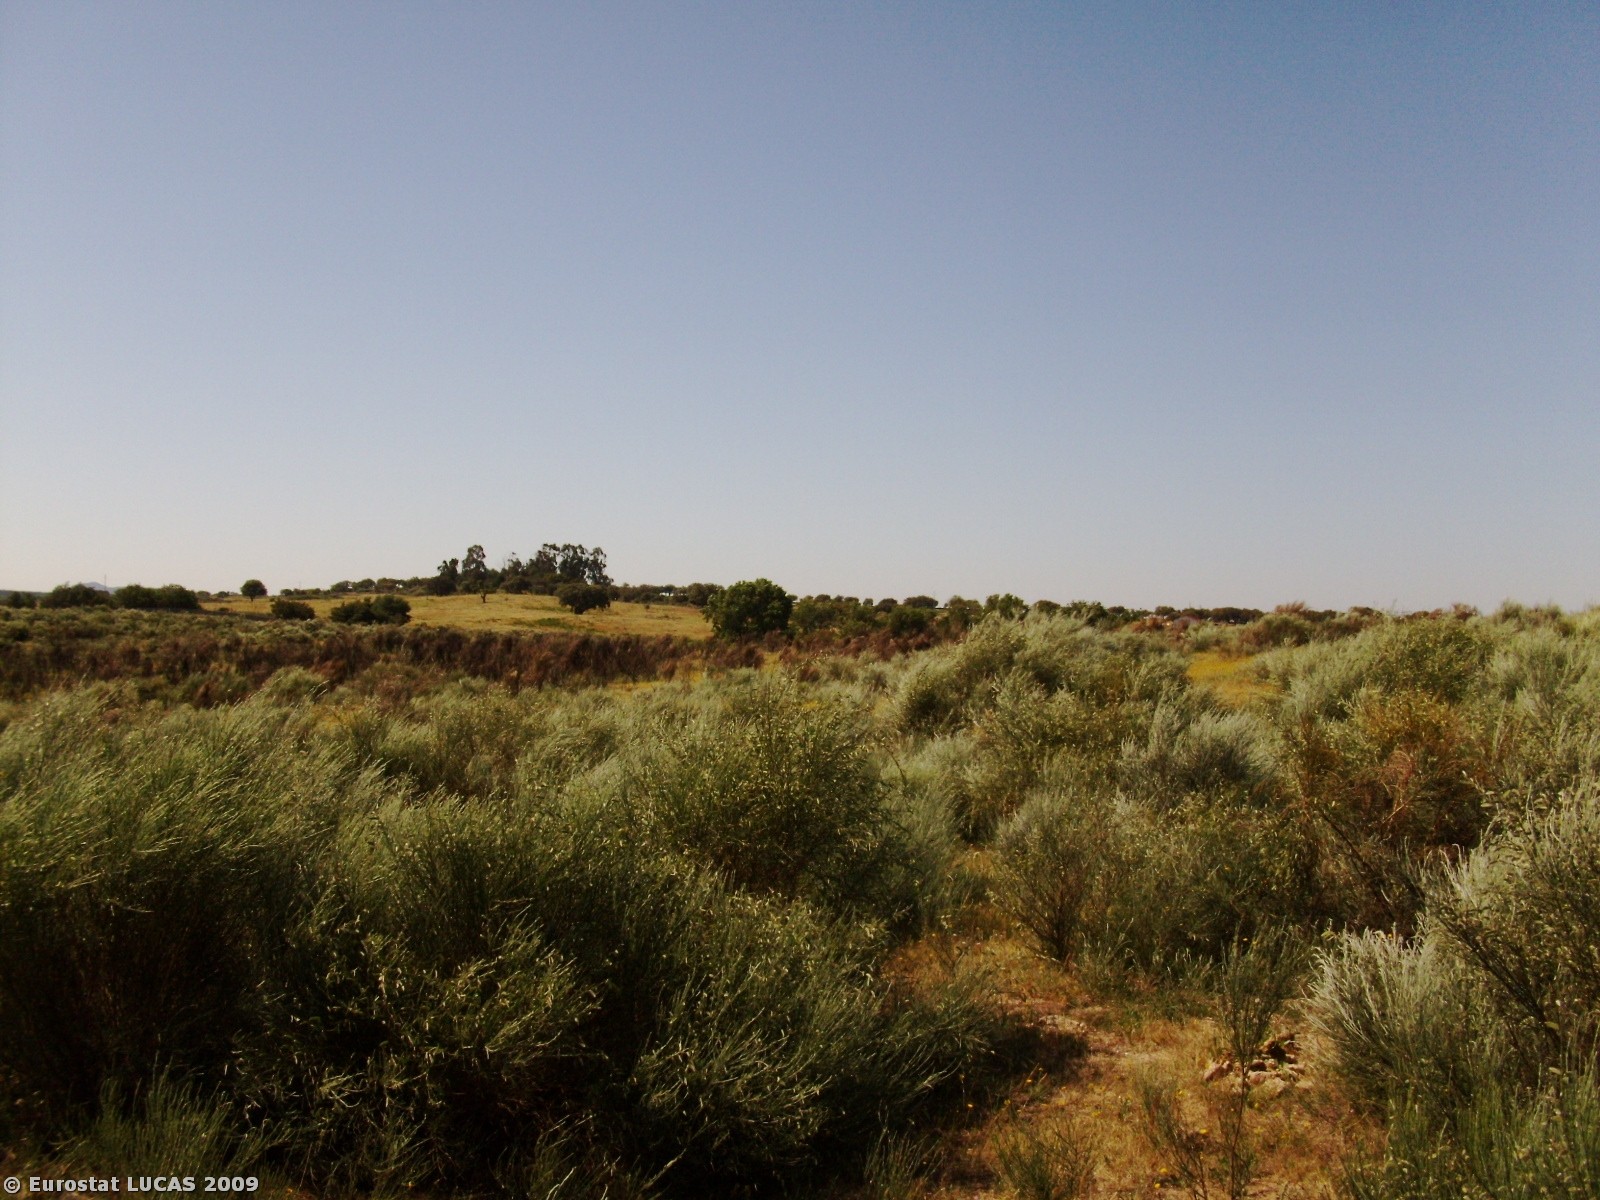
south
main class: Grassland
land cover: Grassland with sparse tree/shrub cover
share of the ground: > 75 %
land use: Agriculture (excluding fallow land and kitchen gardens)
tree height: > 5 m
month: May
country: PT
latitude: 39.4360
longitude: -7.5082
